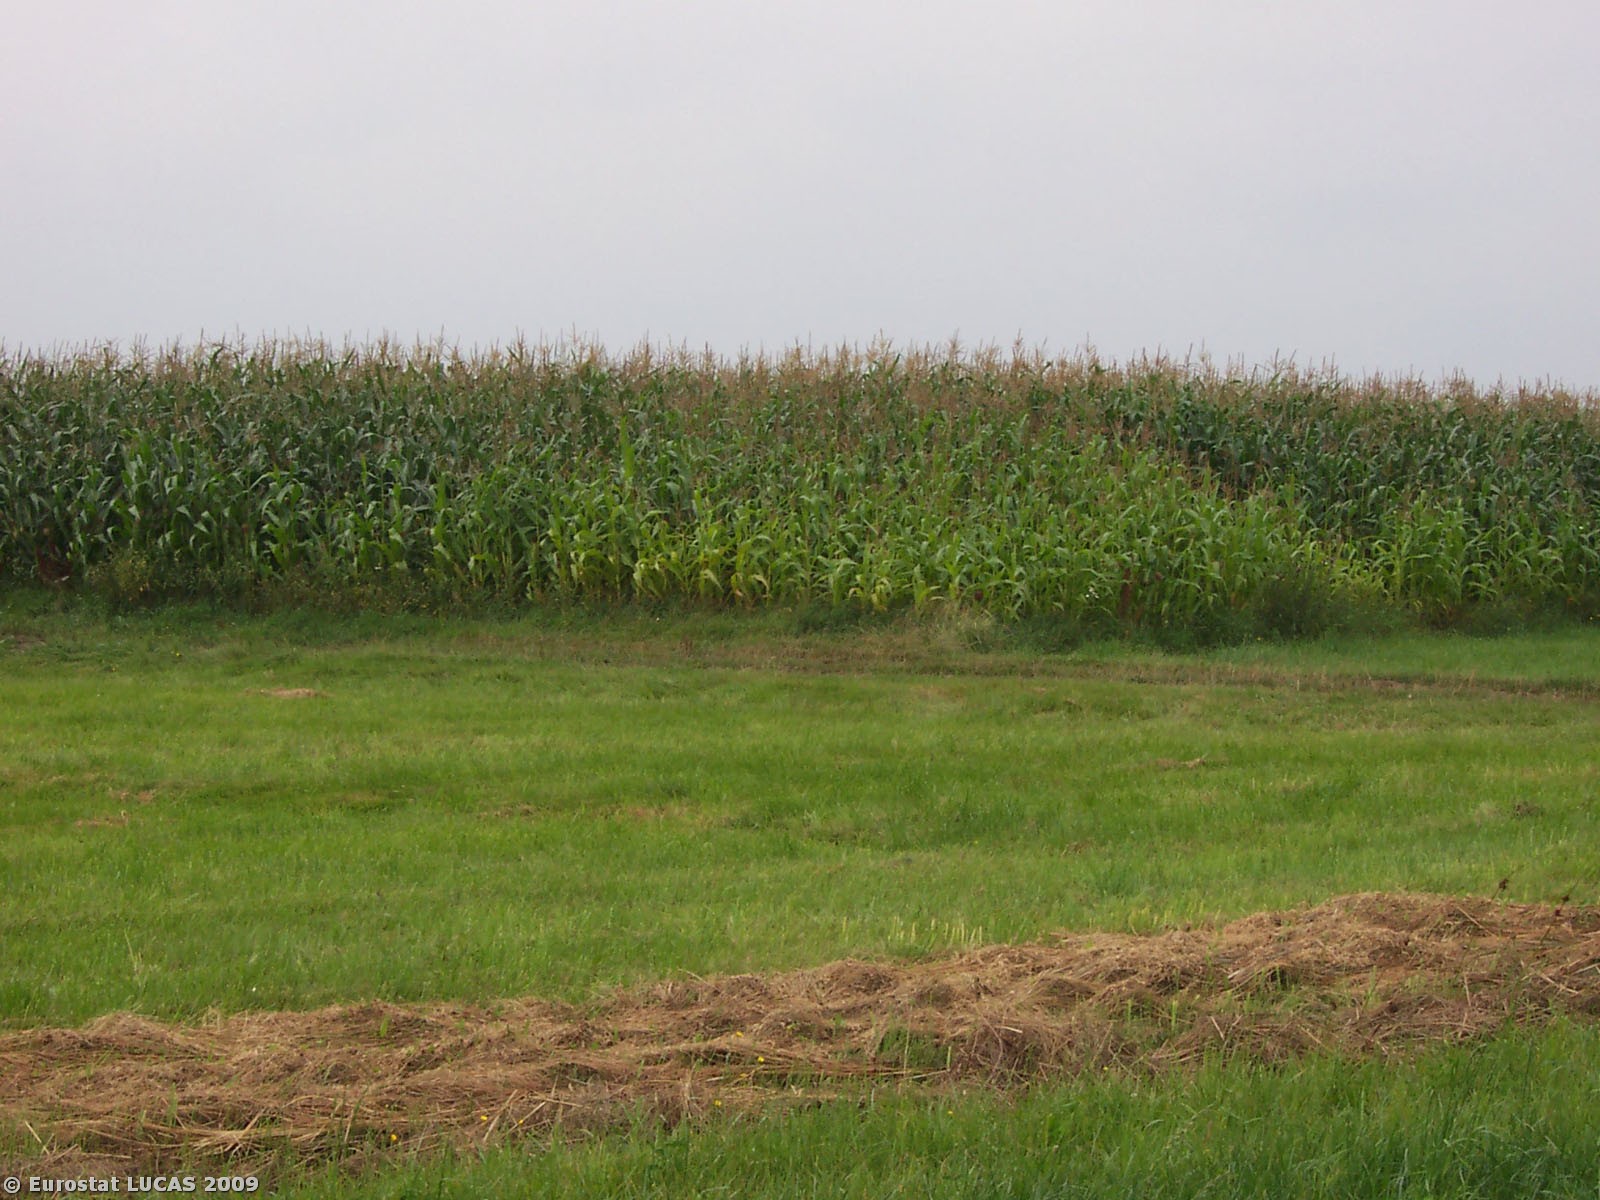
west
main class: Grassland
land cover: Grassland without tree/shrub cover
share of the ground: > 75 %
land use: Agriculture (excluding fallow land and kitchen gardens)
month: August
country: PL
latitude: 53.0777
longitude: 21.2274
